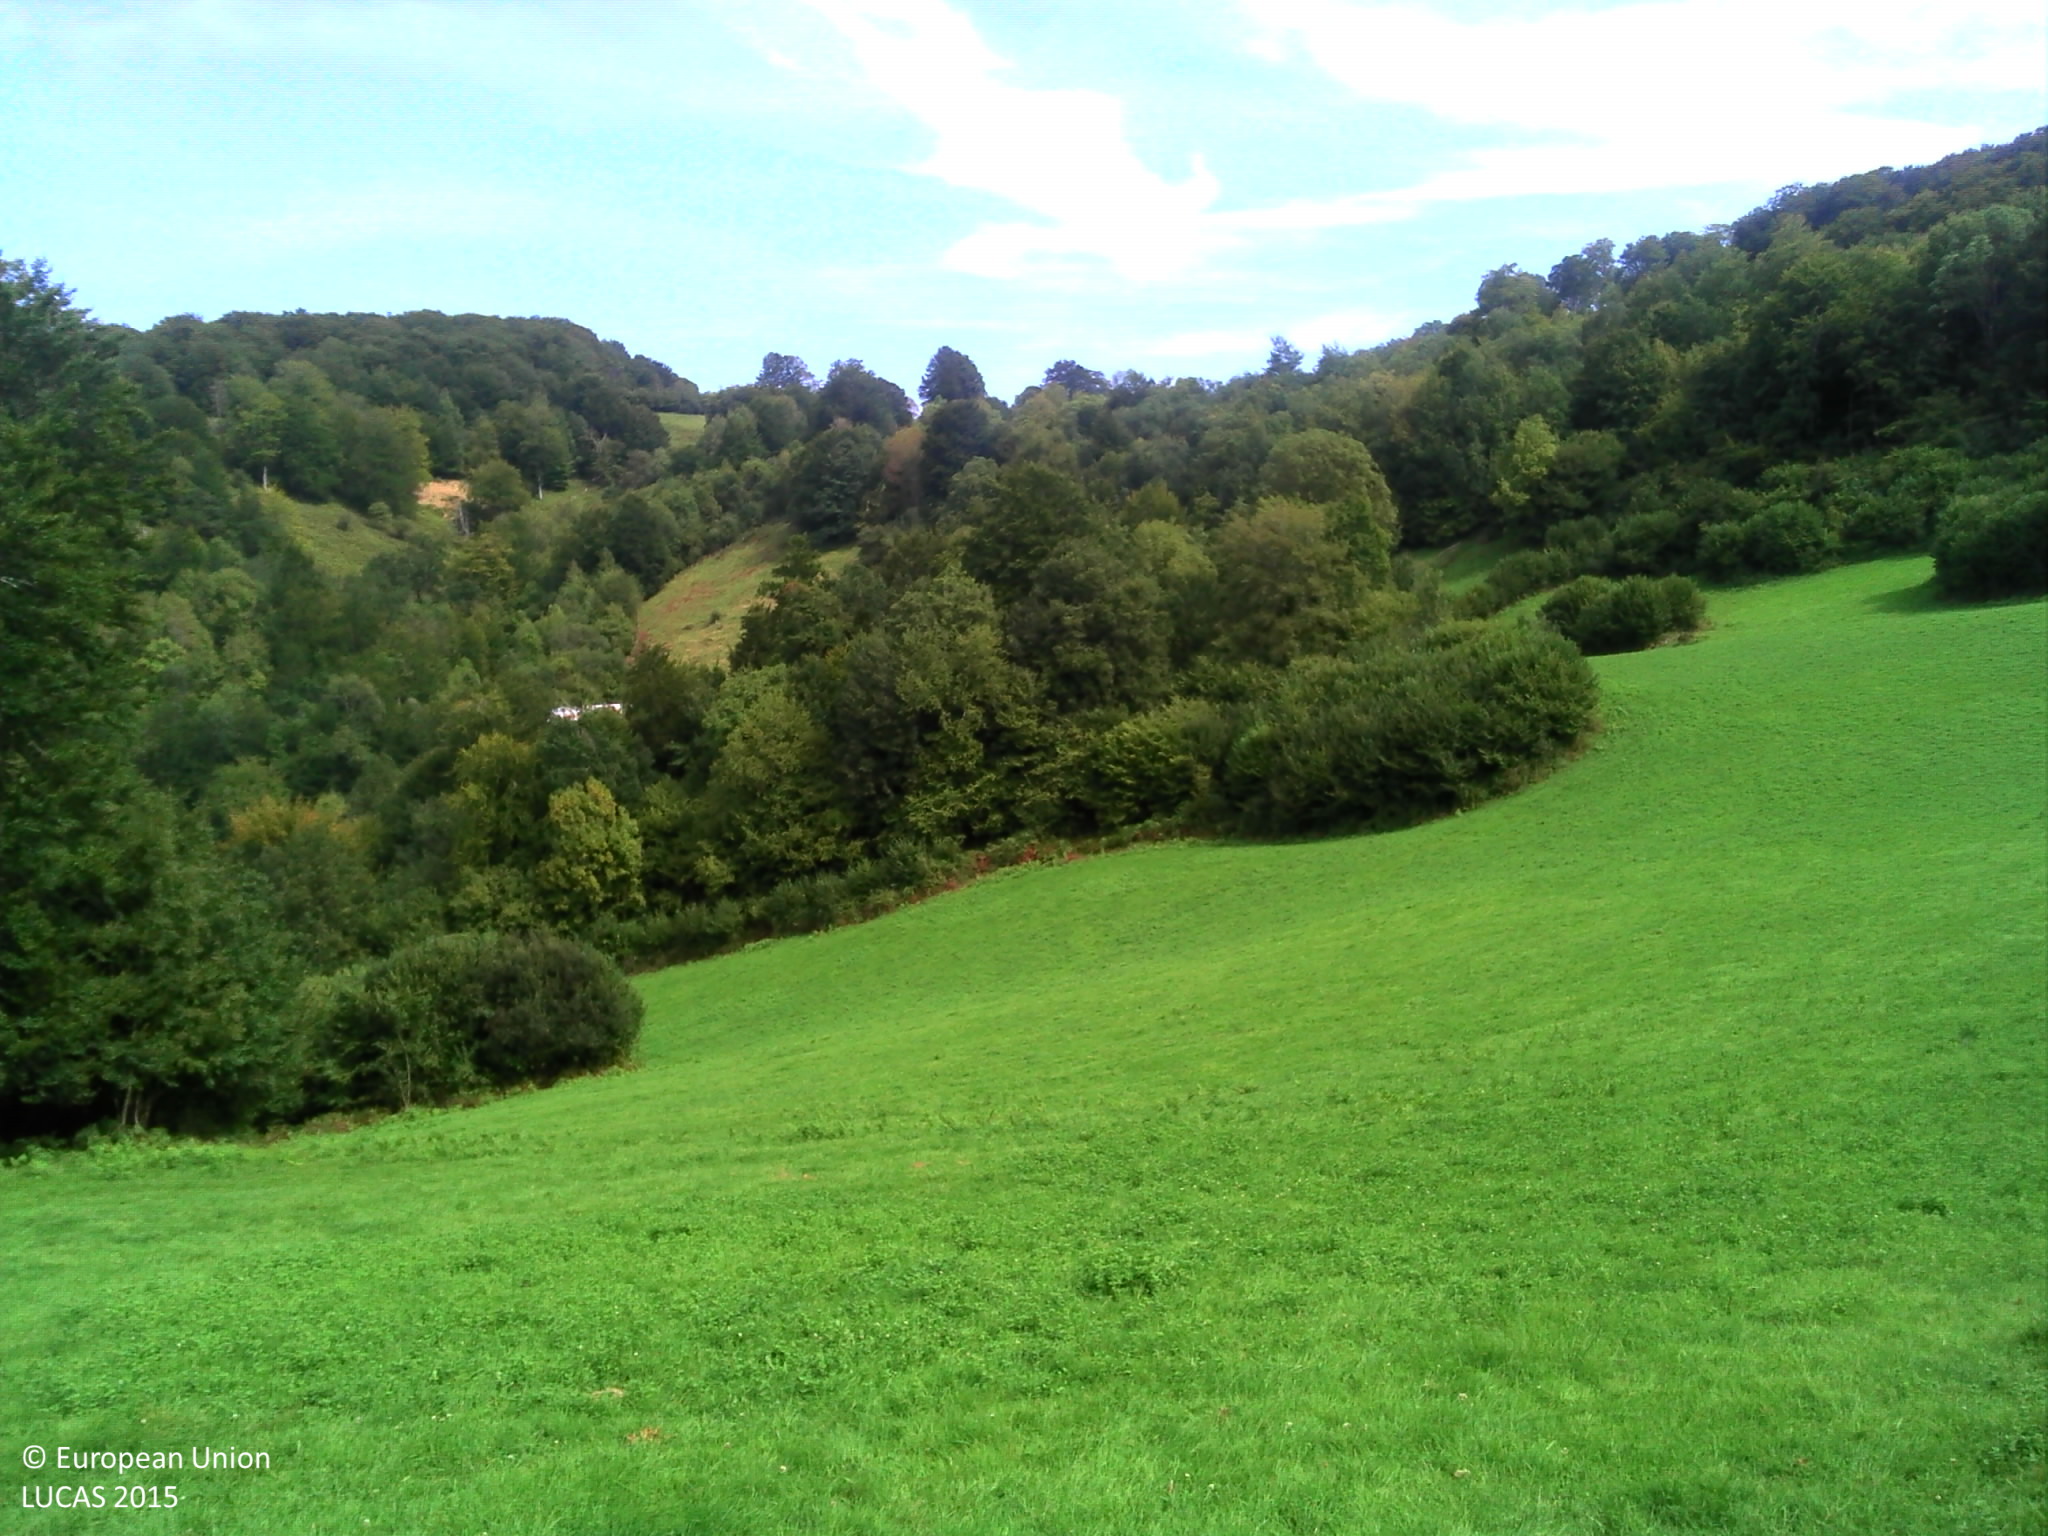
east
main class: Grassland
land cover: Grassland without tree/shrub cover
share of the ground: > 75 %
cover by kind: herbaceous plants 100 %
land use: Agriculture (excluding fallow land and kitchen gardens)
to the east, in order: Grassland without tree/shrub cover; Shruby margins; Broadleaved woodland; Rock outcrops; Broadleaved woodland; Rock outcrops; Broadleaved woodland; Fences; Broadleaved woodland; Grassland without tree/shrub cover
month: September
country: FR
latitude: 43.1615
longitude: -1.0189
